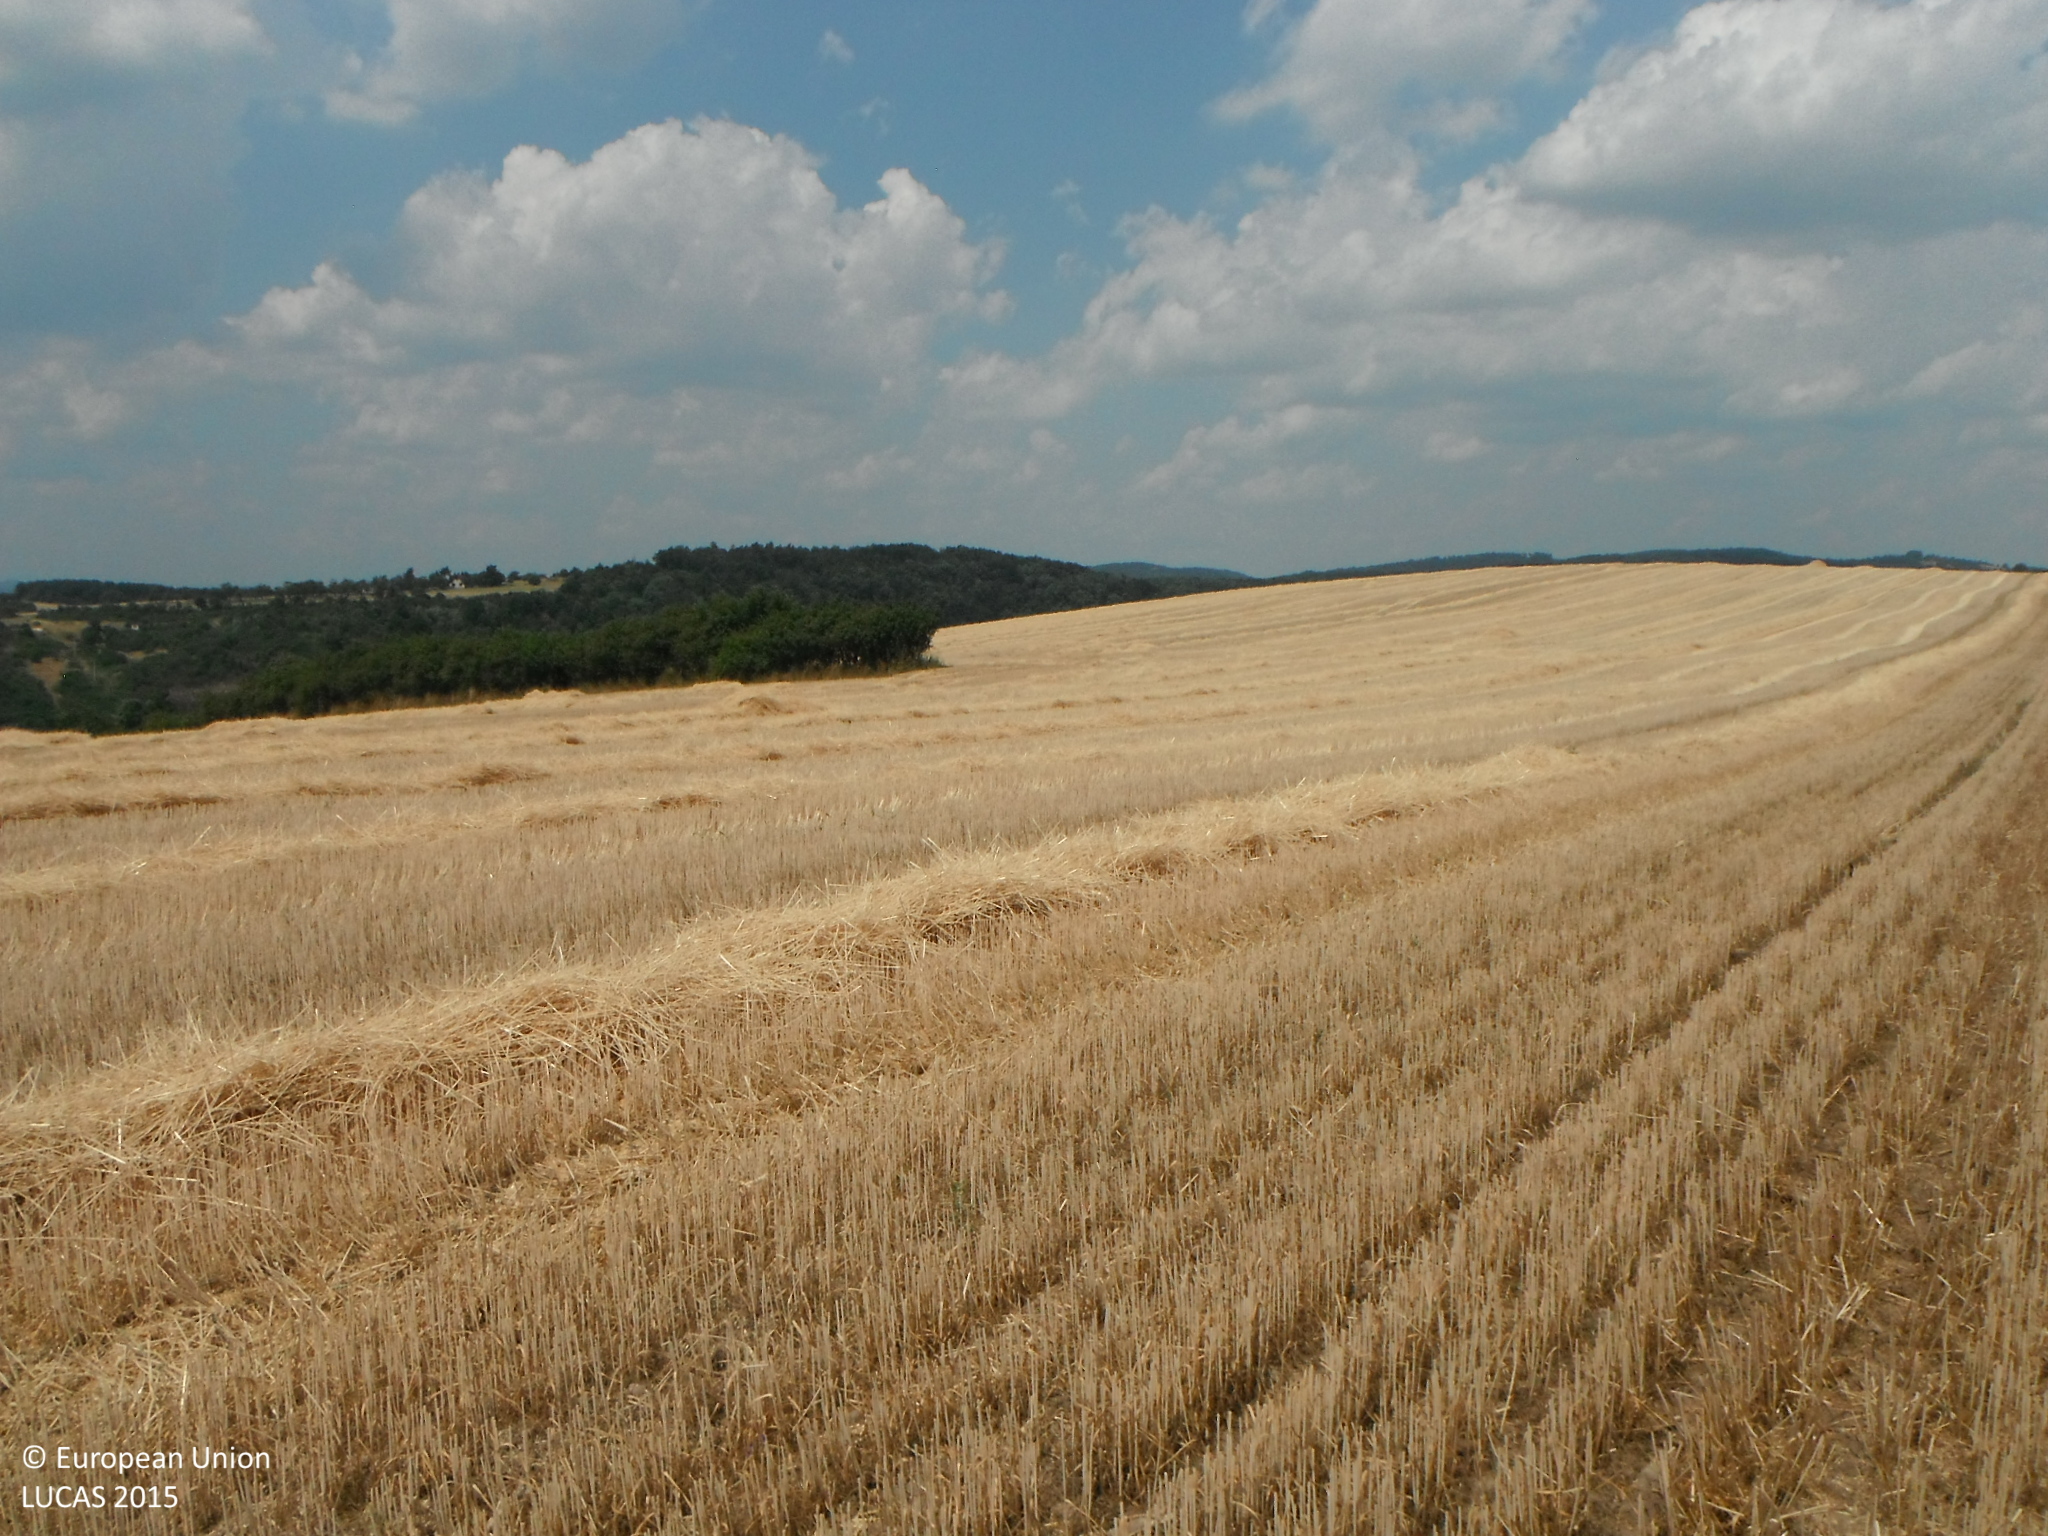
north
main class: Cropland
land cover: Common wheat
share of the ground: > 75 %
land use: Agriculture (excluding fallow land and kitchen gardens)
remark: Harvested field
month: July
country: SK
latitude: 48.3510
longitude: 19.1299
